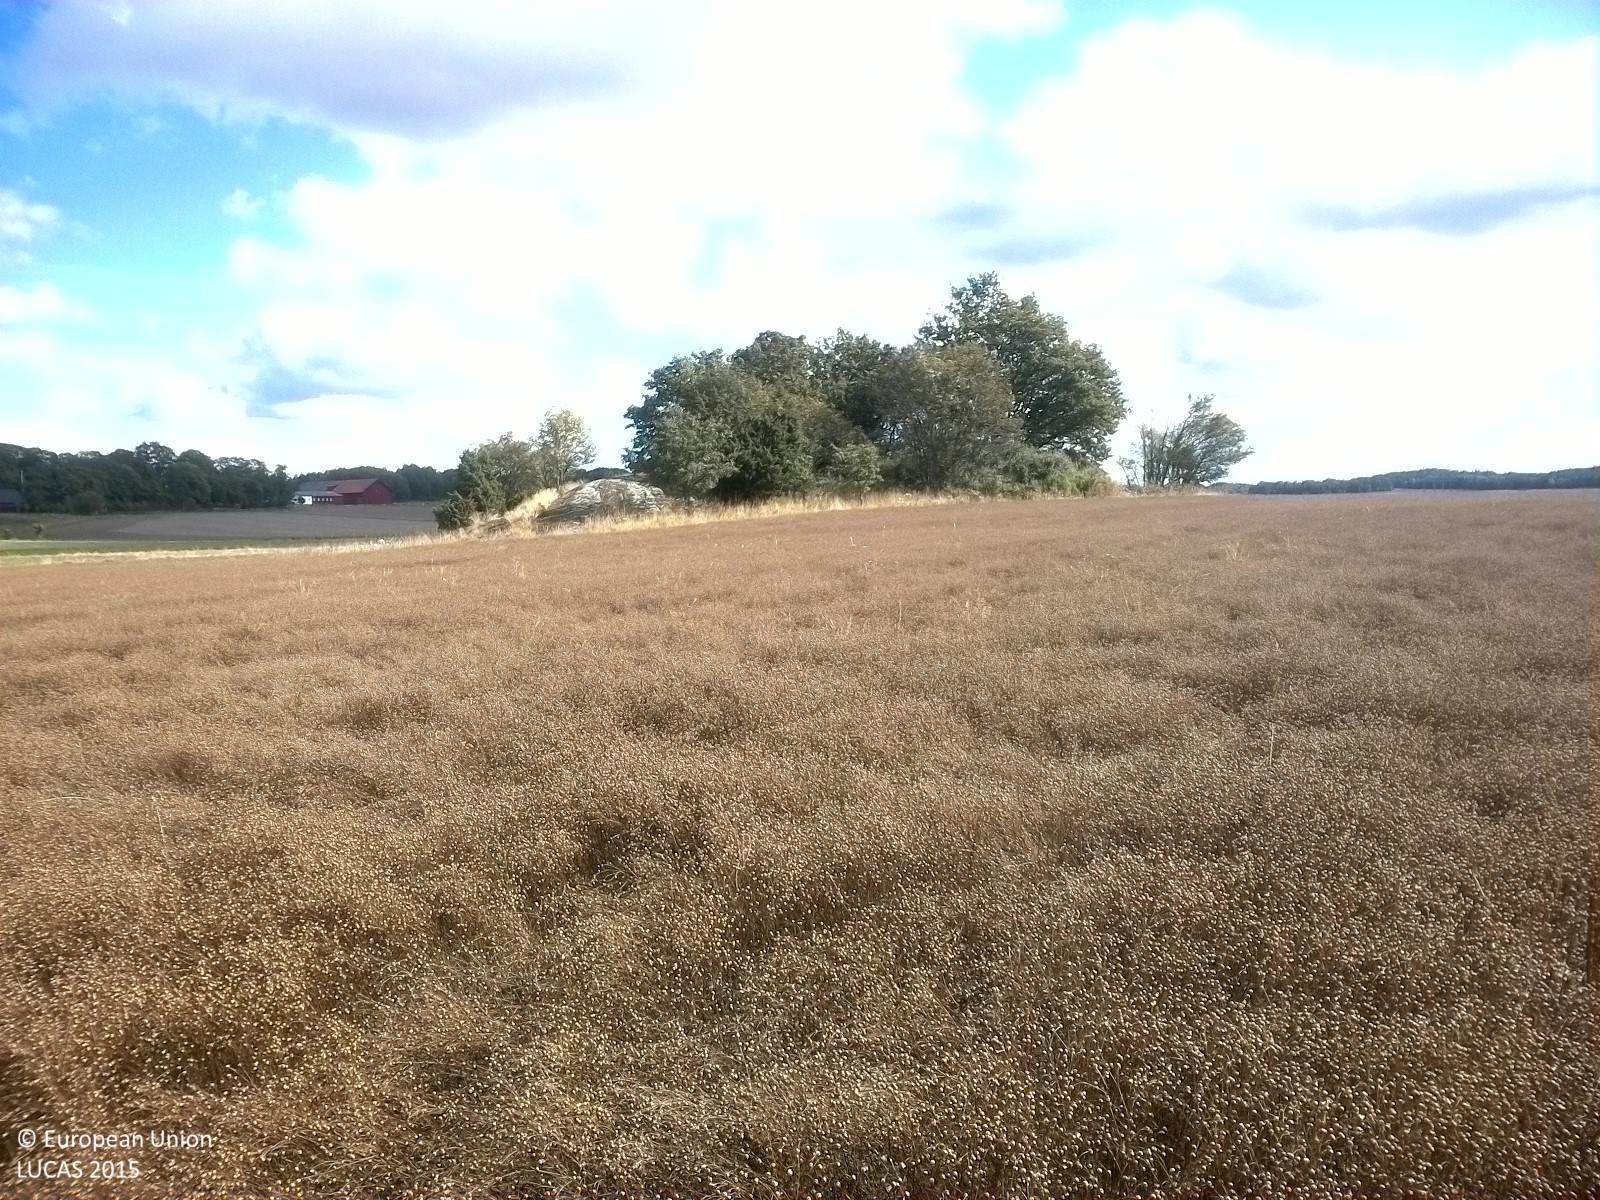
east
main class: Cropland
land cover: Other fibre and oleaginous crops
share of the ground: > 75 %
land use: Agriculture (excluding fallow land and kitchen gardens)
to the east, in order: Other fibre and oleaginous crops; Broadleaved woodland; Other fibre and oleaginous crops; Grassland without tree/shrub cover
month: September
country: SE
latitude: 58.5622
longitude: 16.2351
